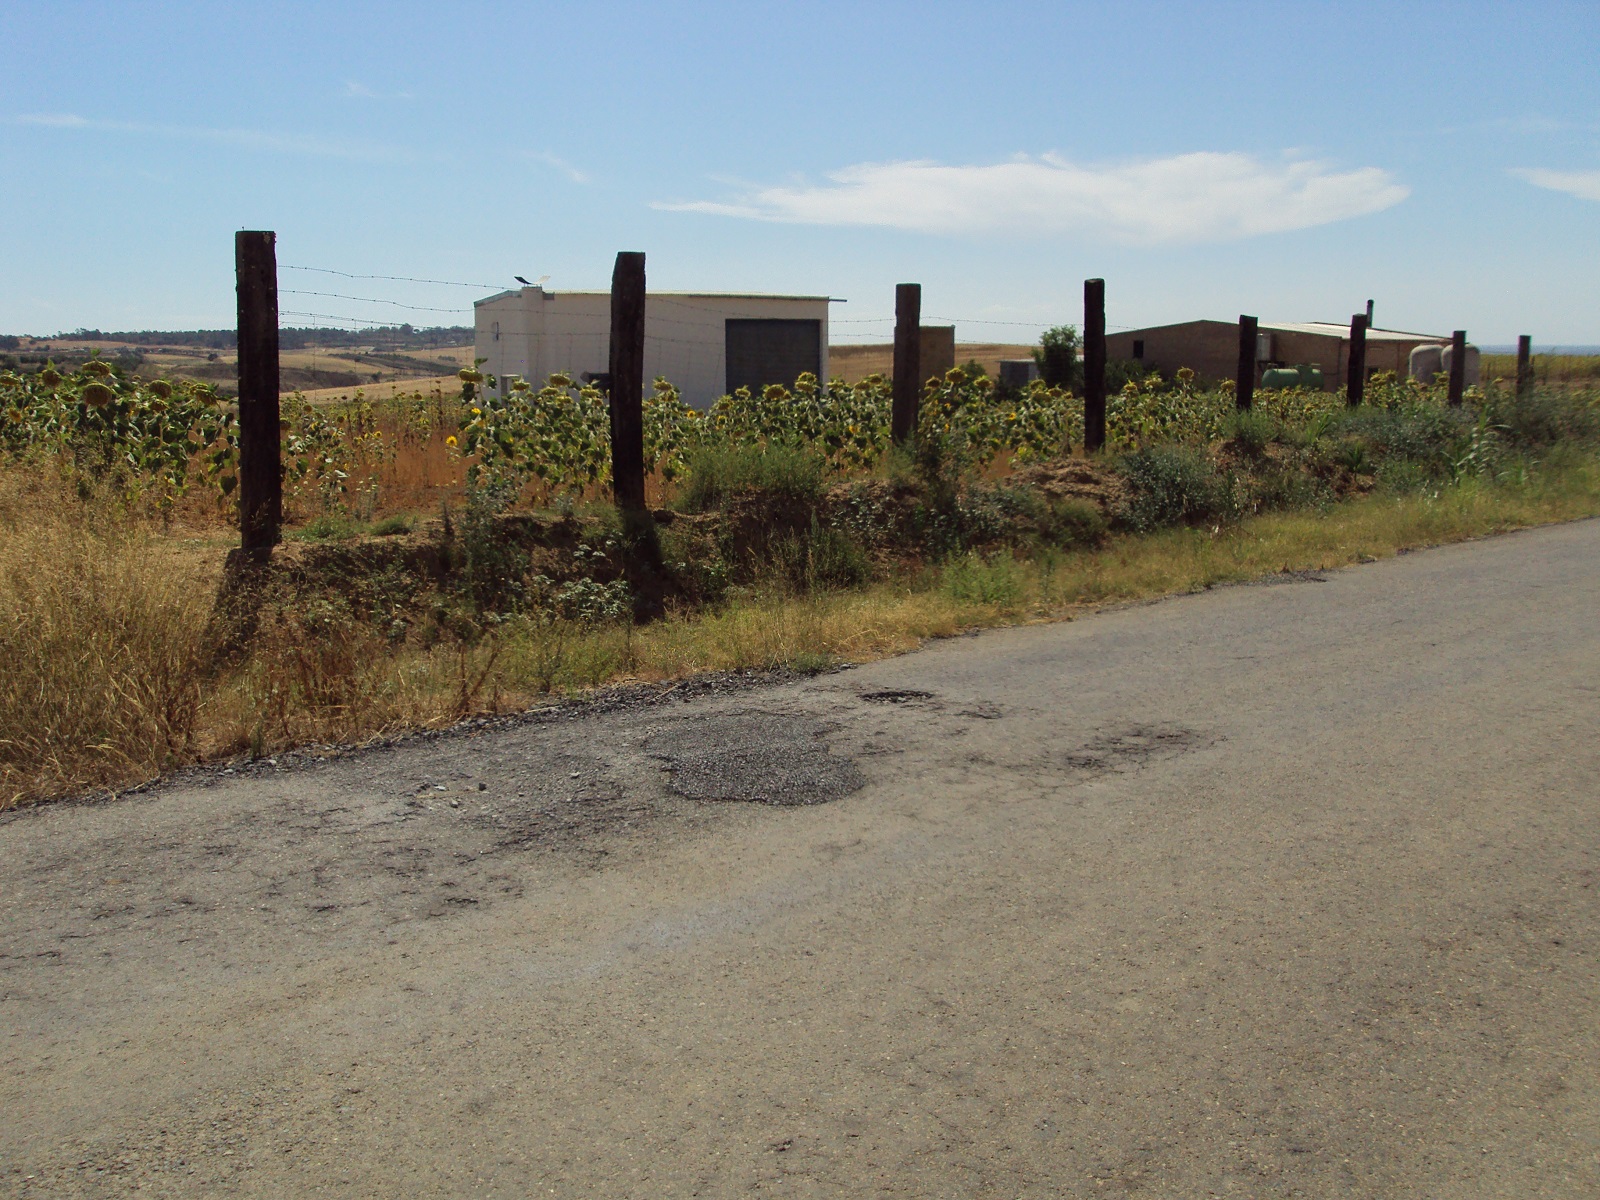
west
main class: Cropland
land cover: Dry pulses
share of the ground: > 75 %
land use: Agriculture (excluding fallow land and kitchen gardens)
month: June
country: ES
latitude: 37.3787
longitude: -6.5323
